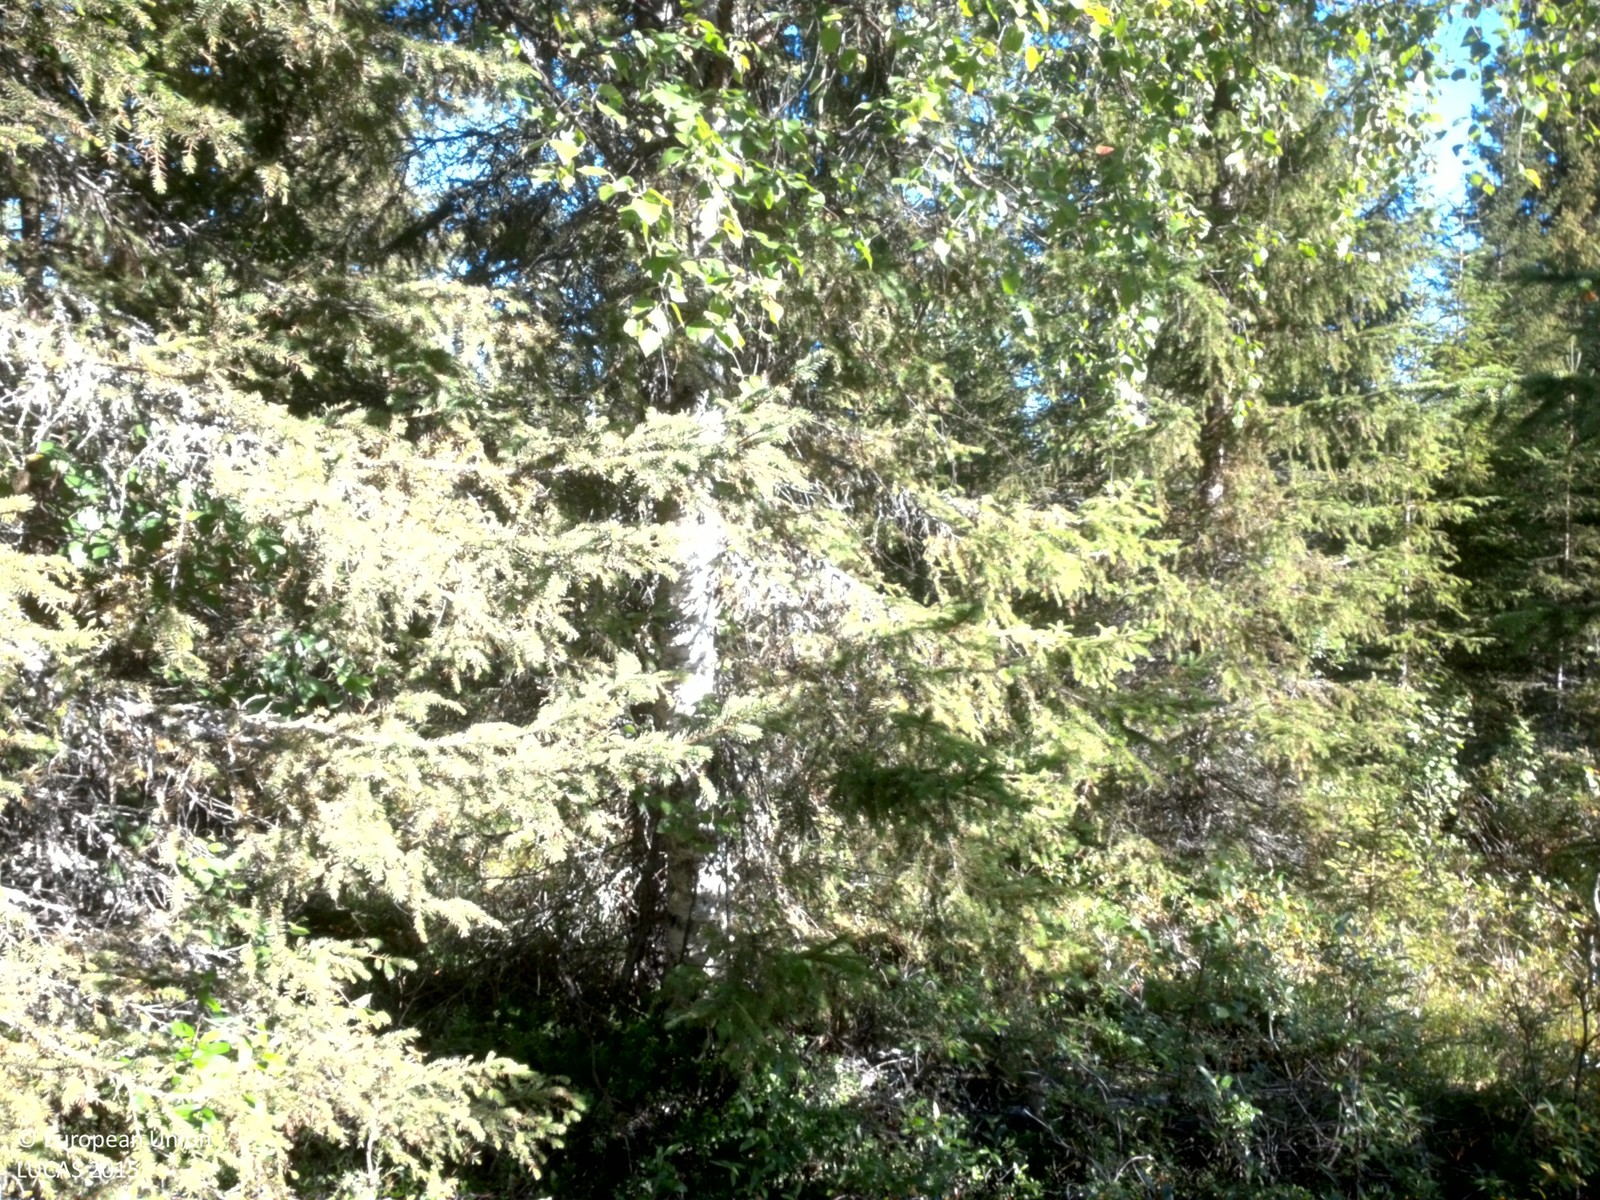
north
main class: Woodland
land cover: Spruce dominated mixed woodland
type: boreal forest
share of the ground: > 75 %
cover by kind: coniferous forest trees 60 %, broadleaved forest trees 20 %, shrubs 15 %, lichens and mosses 5 %
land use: Forestry
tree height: > 5 m
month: August
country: SE
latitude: 64.4468
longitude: 18.4253
